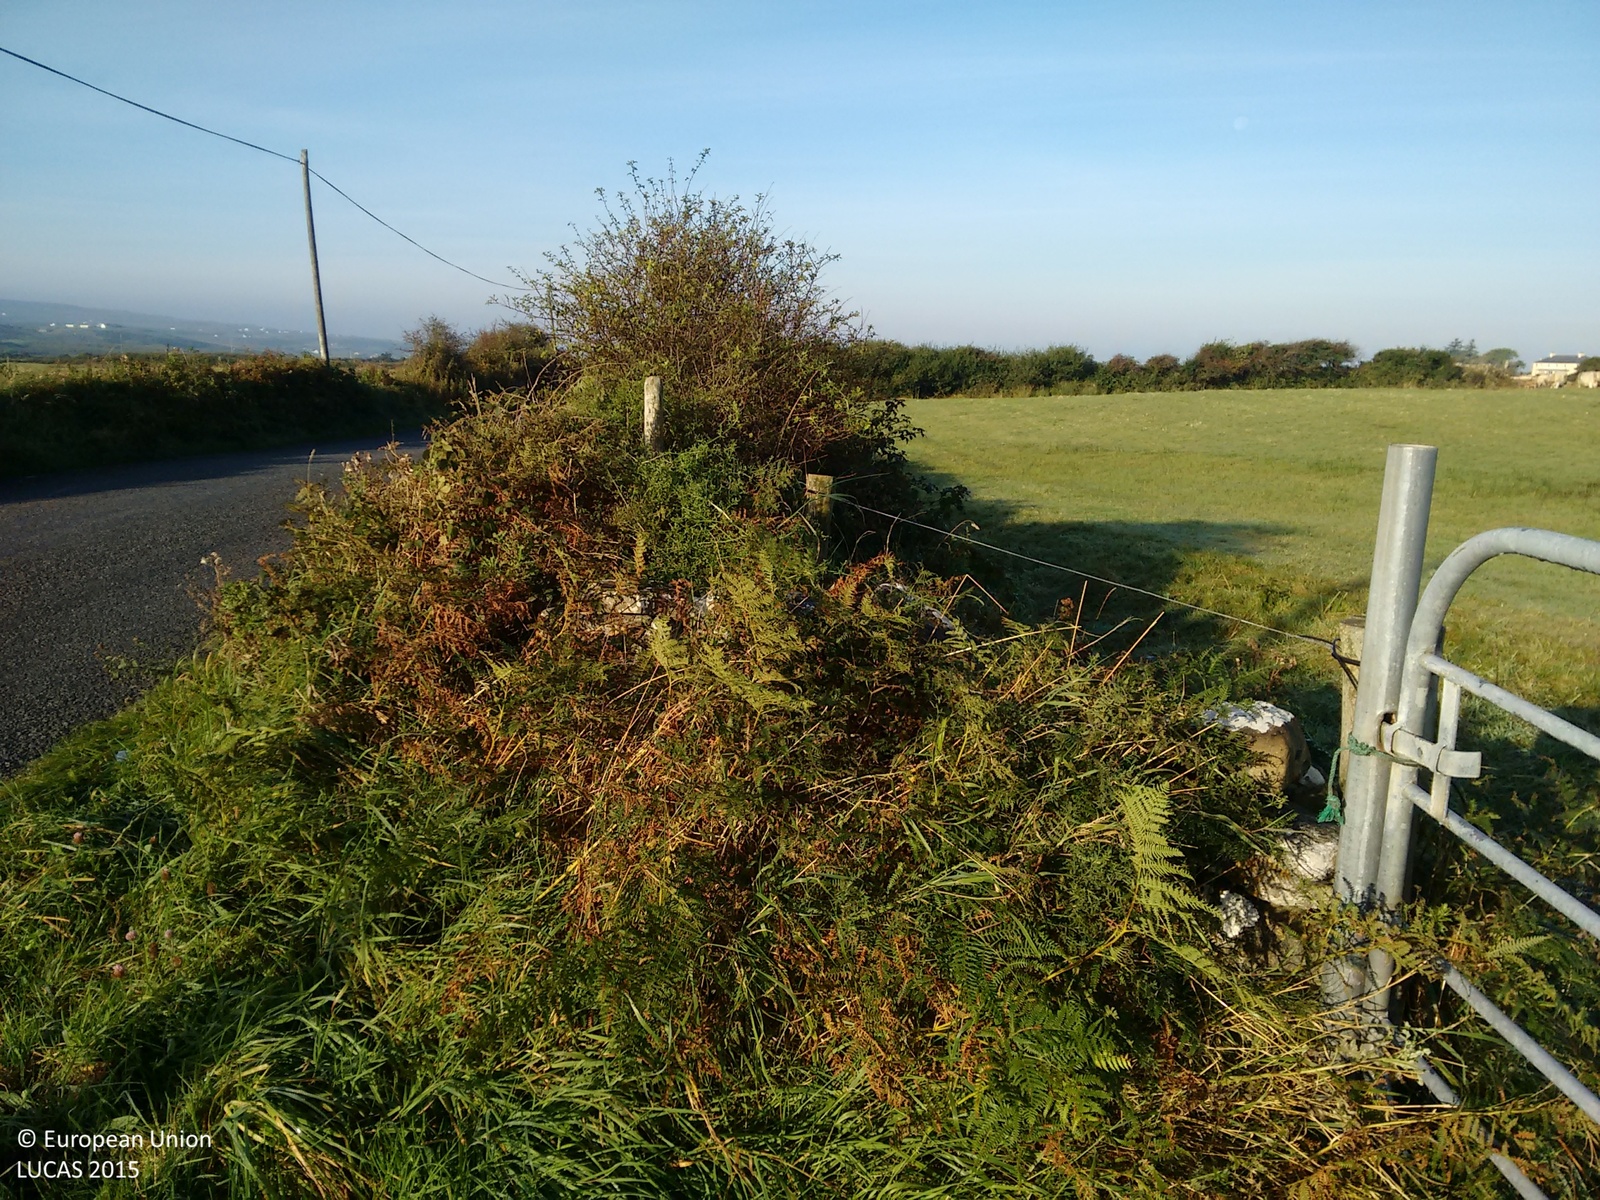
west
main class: Grassland
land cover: Grassland without tree/shrub cover
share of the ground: > 75 %
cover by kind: herbaceous plants 100 %
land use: Agriculture (excluding fallow land and kitchen gardens)
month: September
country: IE
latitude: 53.0266
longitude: -9.3252
